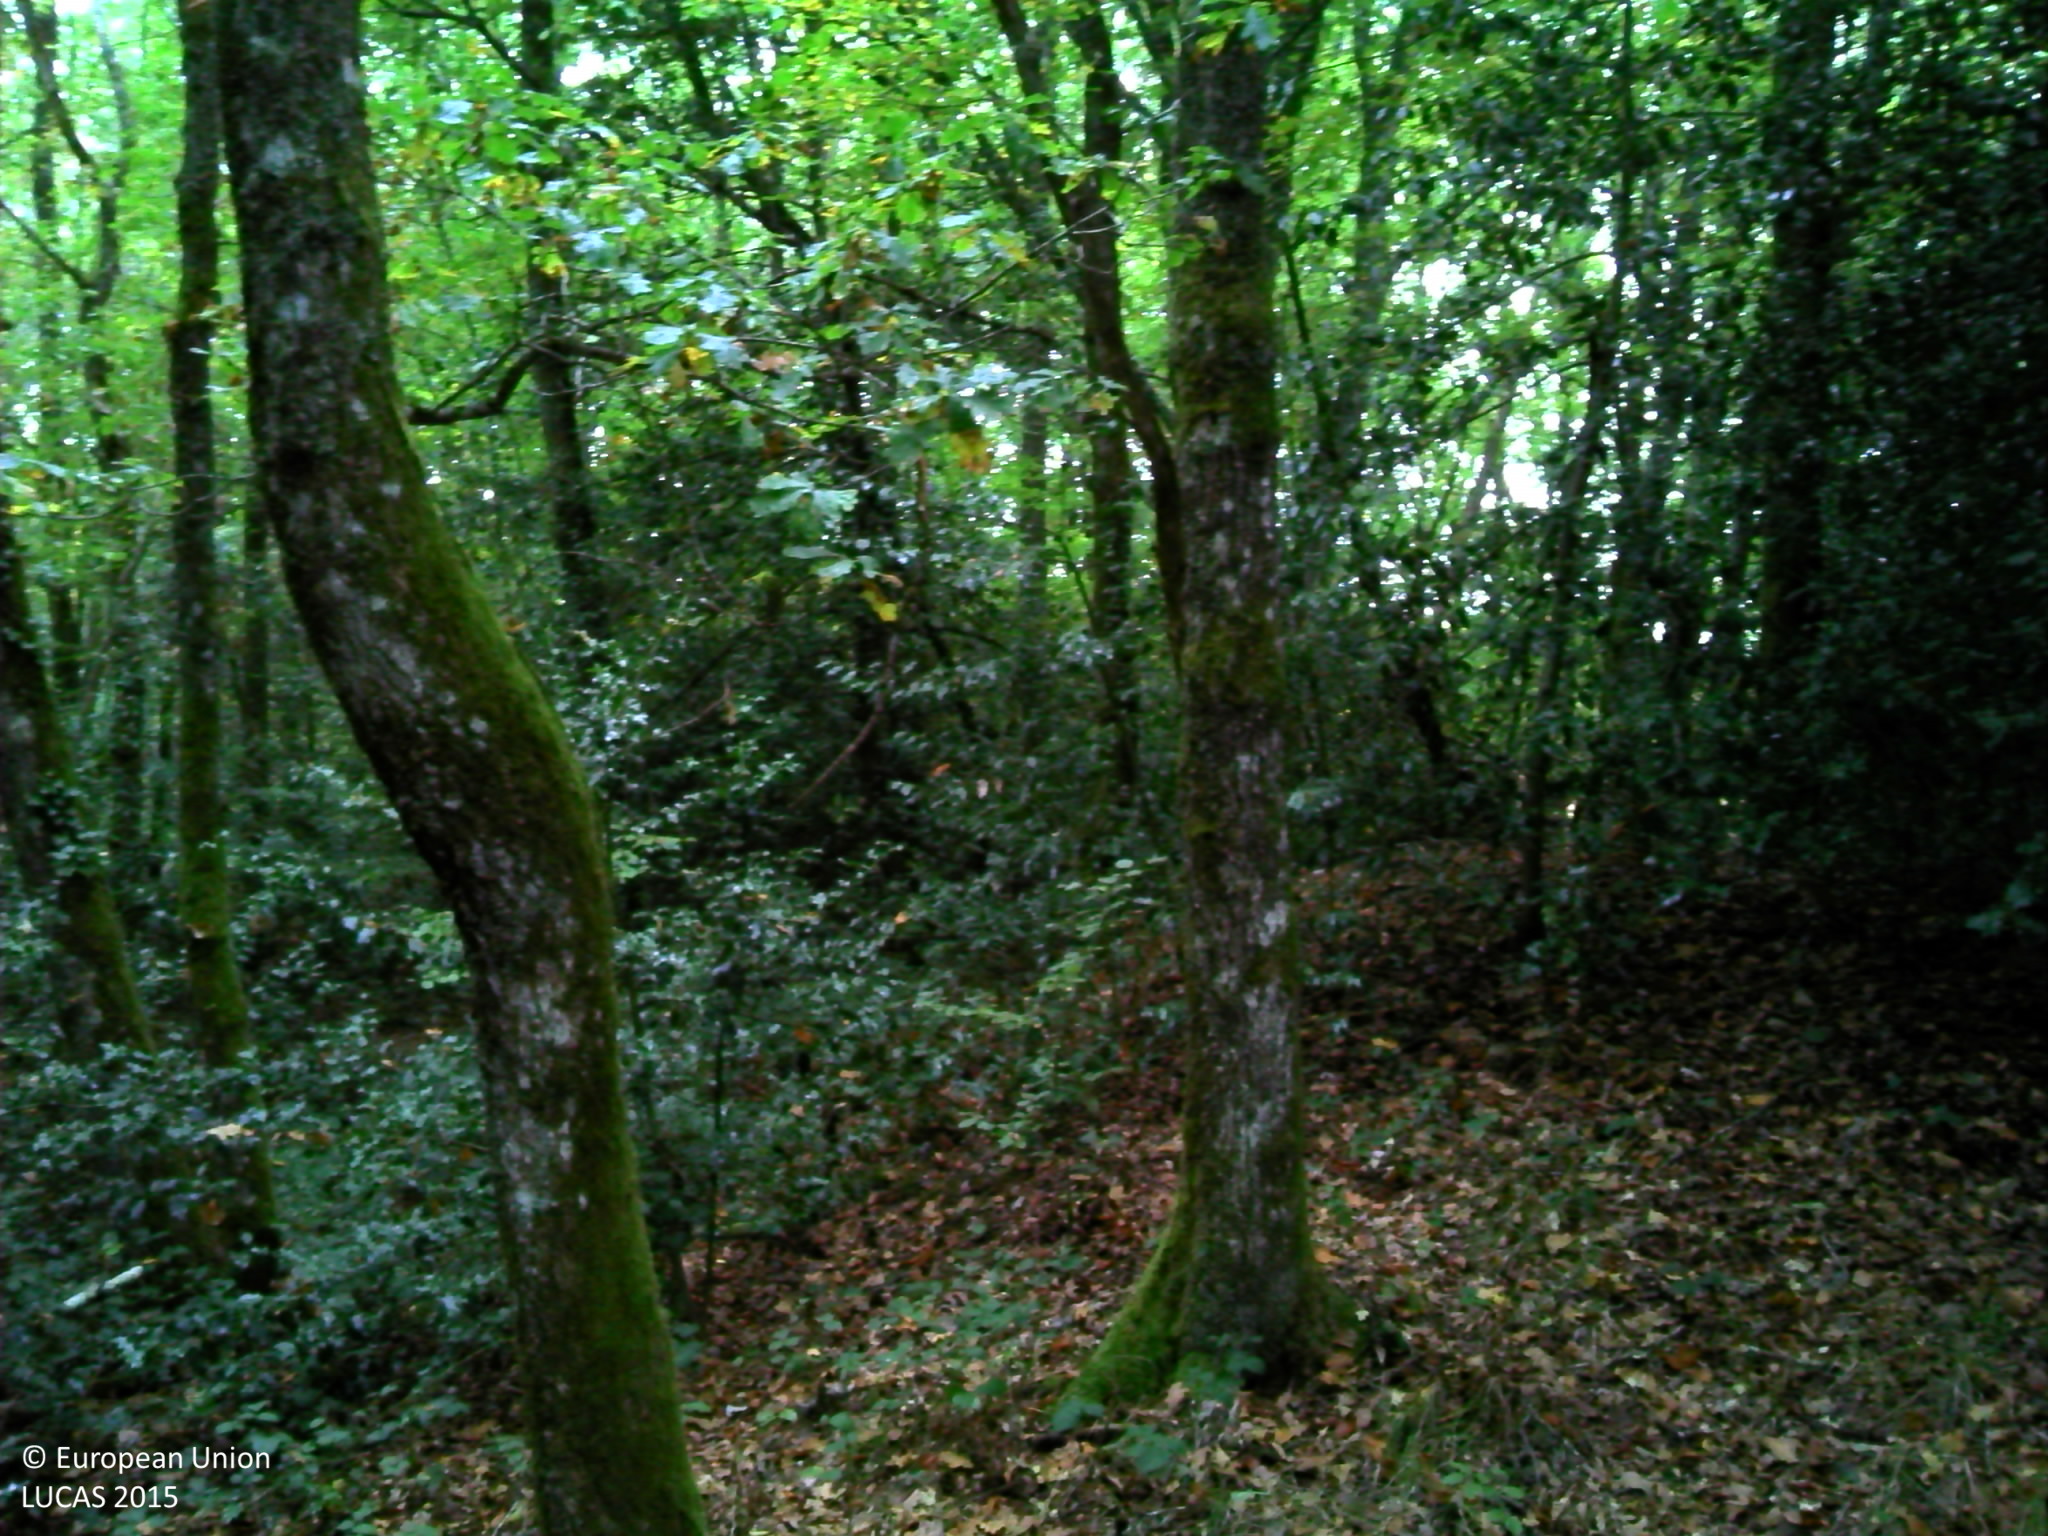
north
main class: Woodland
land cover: Broadleaved woodland
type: beech forest
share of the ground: > 75 %
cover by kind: broadleaved forest trees 85 %, herbaceous plants 15 %
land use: Forestry
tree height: > 5 m
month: October
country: FR
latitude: 45.9124
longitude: 2.8433
